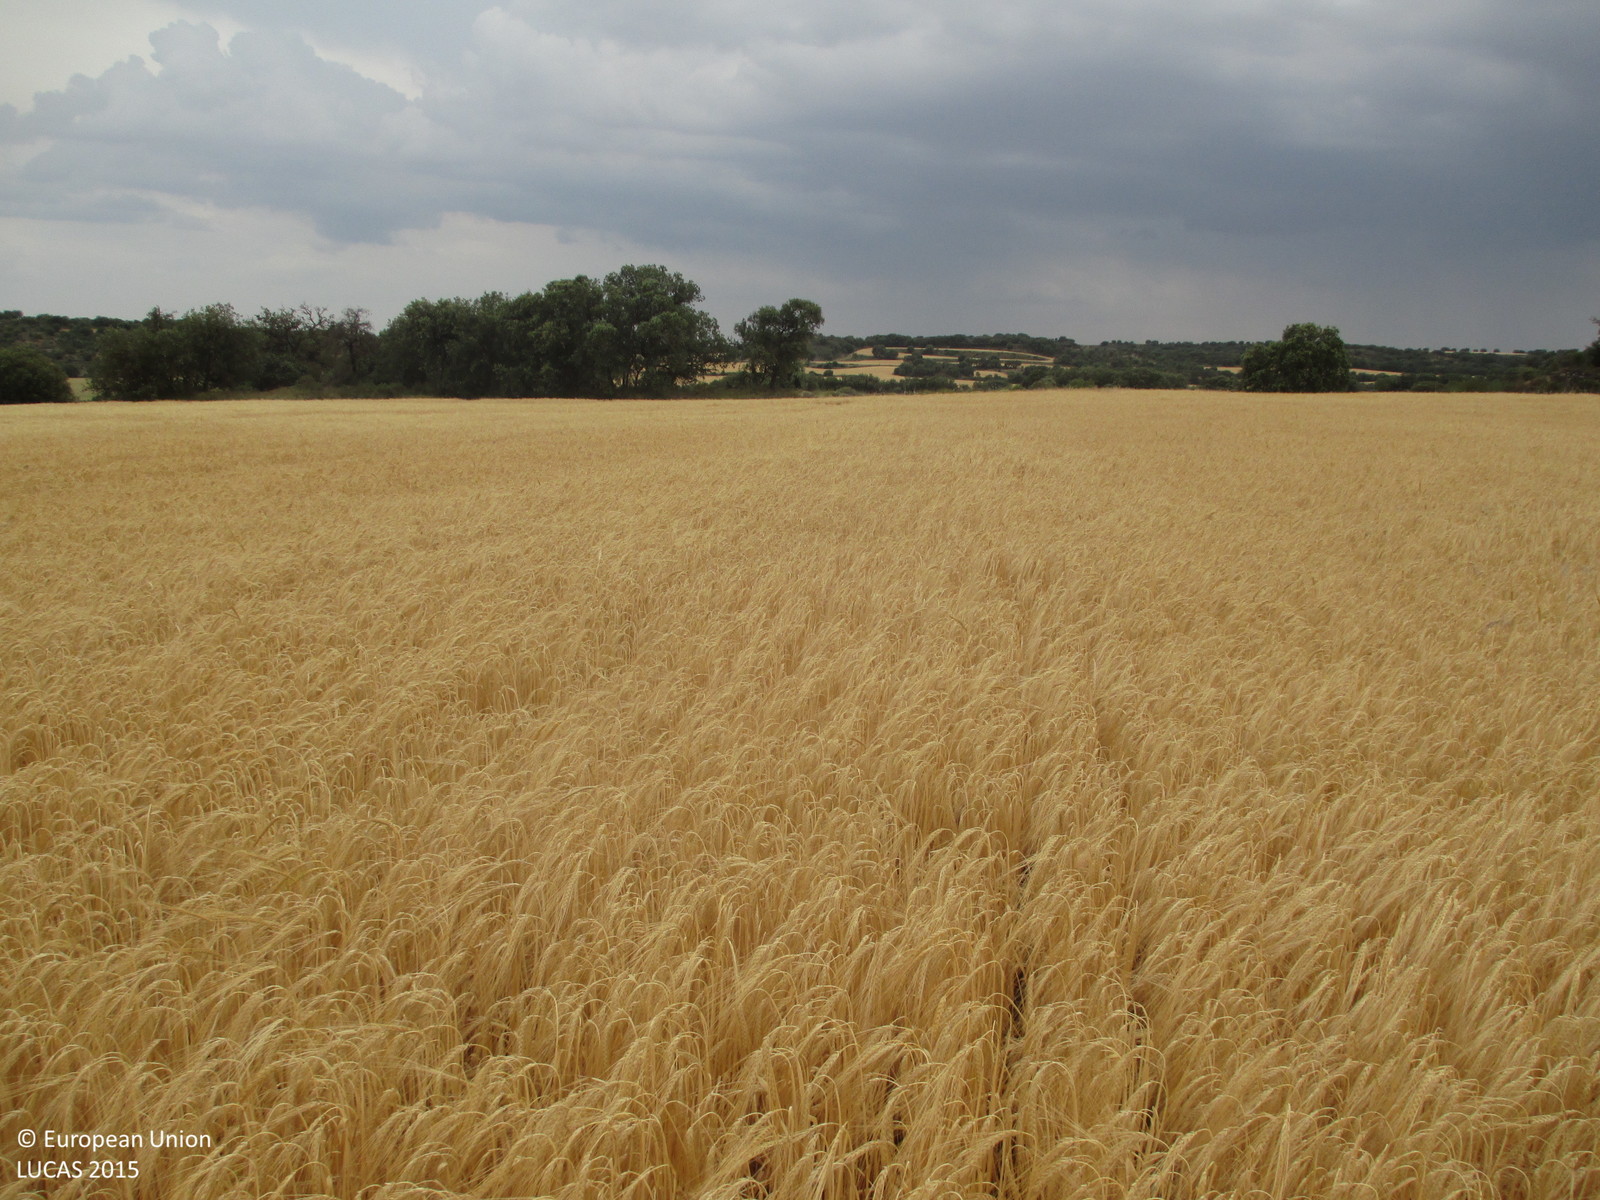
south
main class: Cropland
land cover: Barley
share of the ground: > 75 %
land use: Agriculture (excluding fallow land and kitchen gardens)
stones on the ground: < 10 %
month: May
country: ES
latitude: 42.1000
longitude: -0.2142
